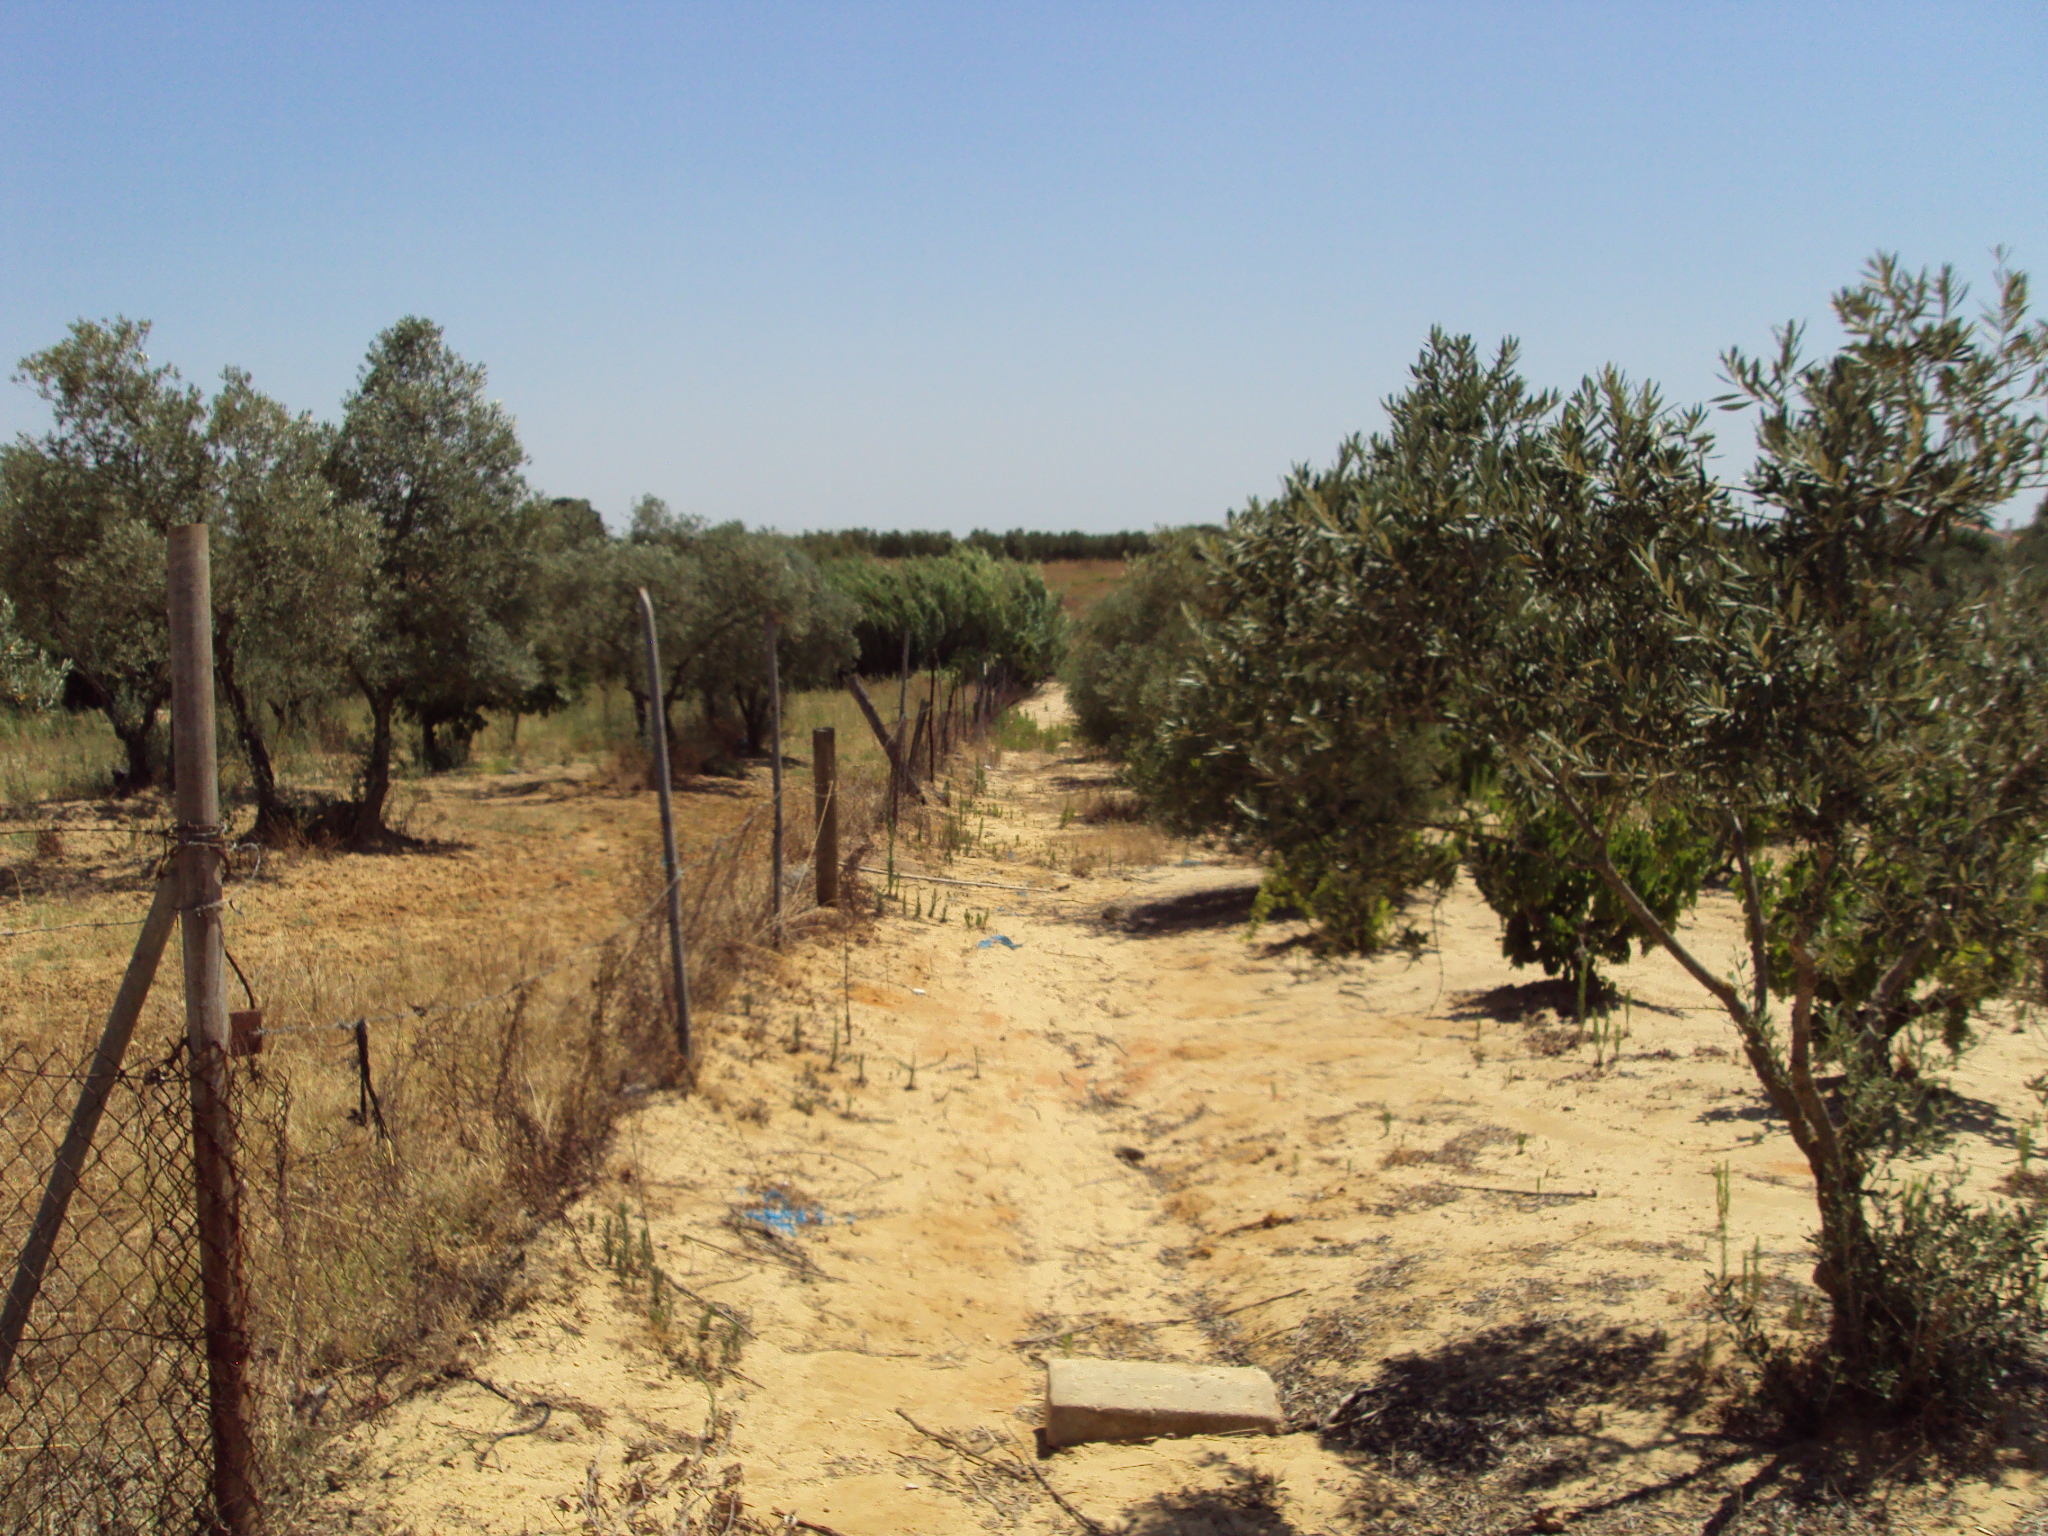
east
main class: Cropland
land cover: Other fresh vegetables
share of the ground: 10 - 25 %
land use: Agriculture (excluding fallow land and kitchen gardens)
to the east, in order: Other fresh vegetables; Tracks; Vineyards; Spontaneously vegetated surfaces; Rivers and streams; Abandoned hedges; Spontaneously vegetated surfaces; Grass margins; Olive groves
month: July
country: ES
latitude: 37.2471
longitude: -6.5463
